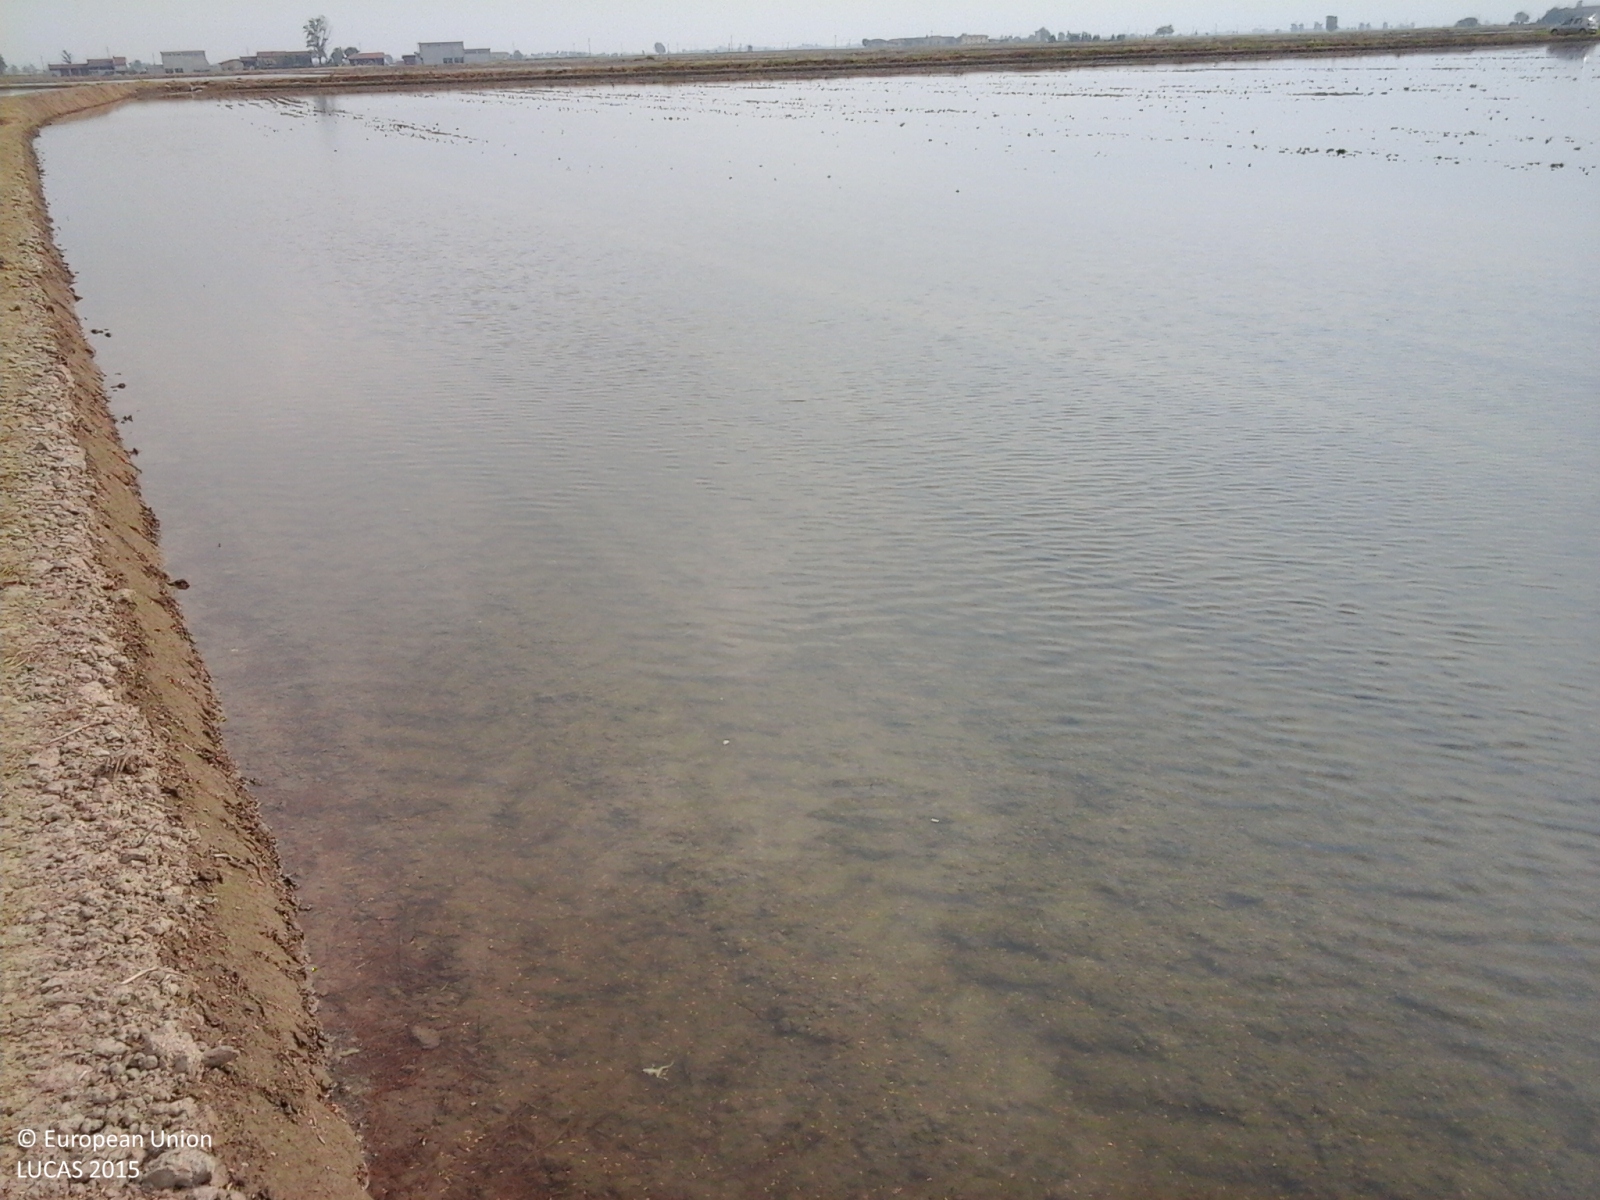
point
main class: Cropland
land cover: Rice
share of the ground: < 10 %
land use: Agriculture (excluding fallow land and kitchen gardens)
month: May
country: IT
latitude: 45.2711
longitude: 8.1041
